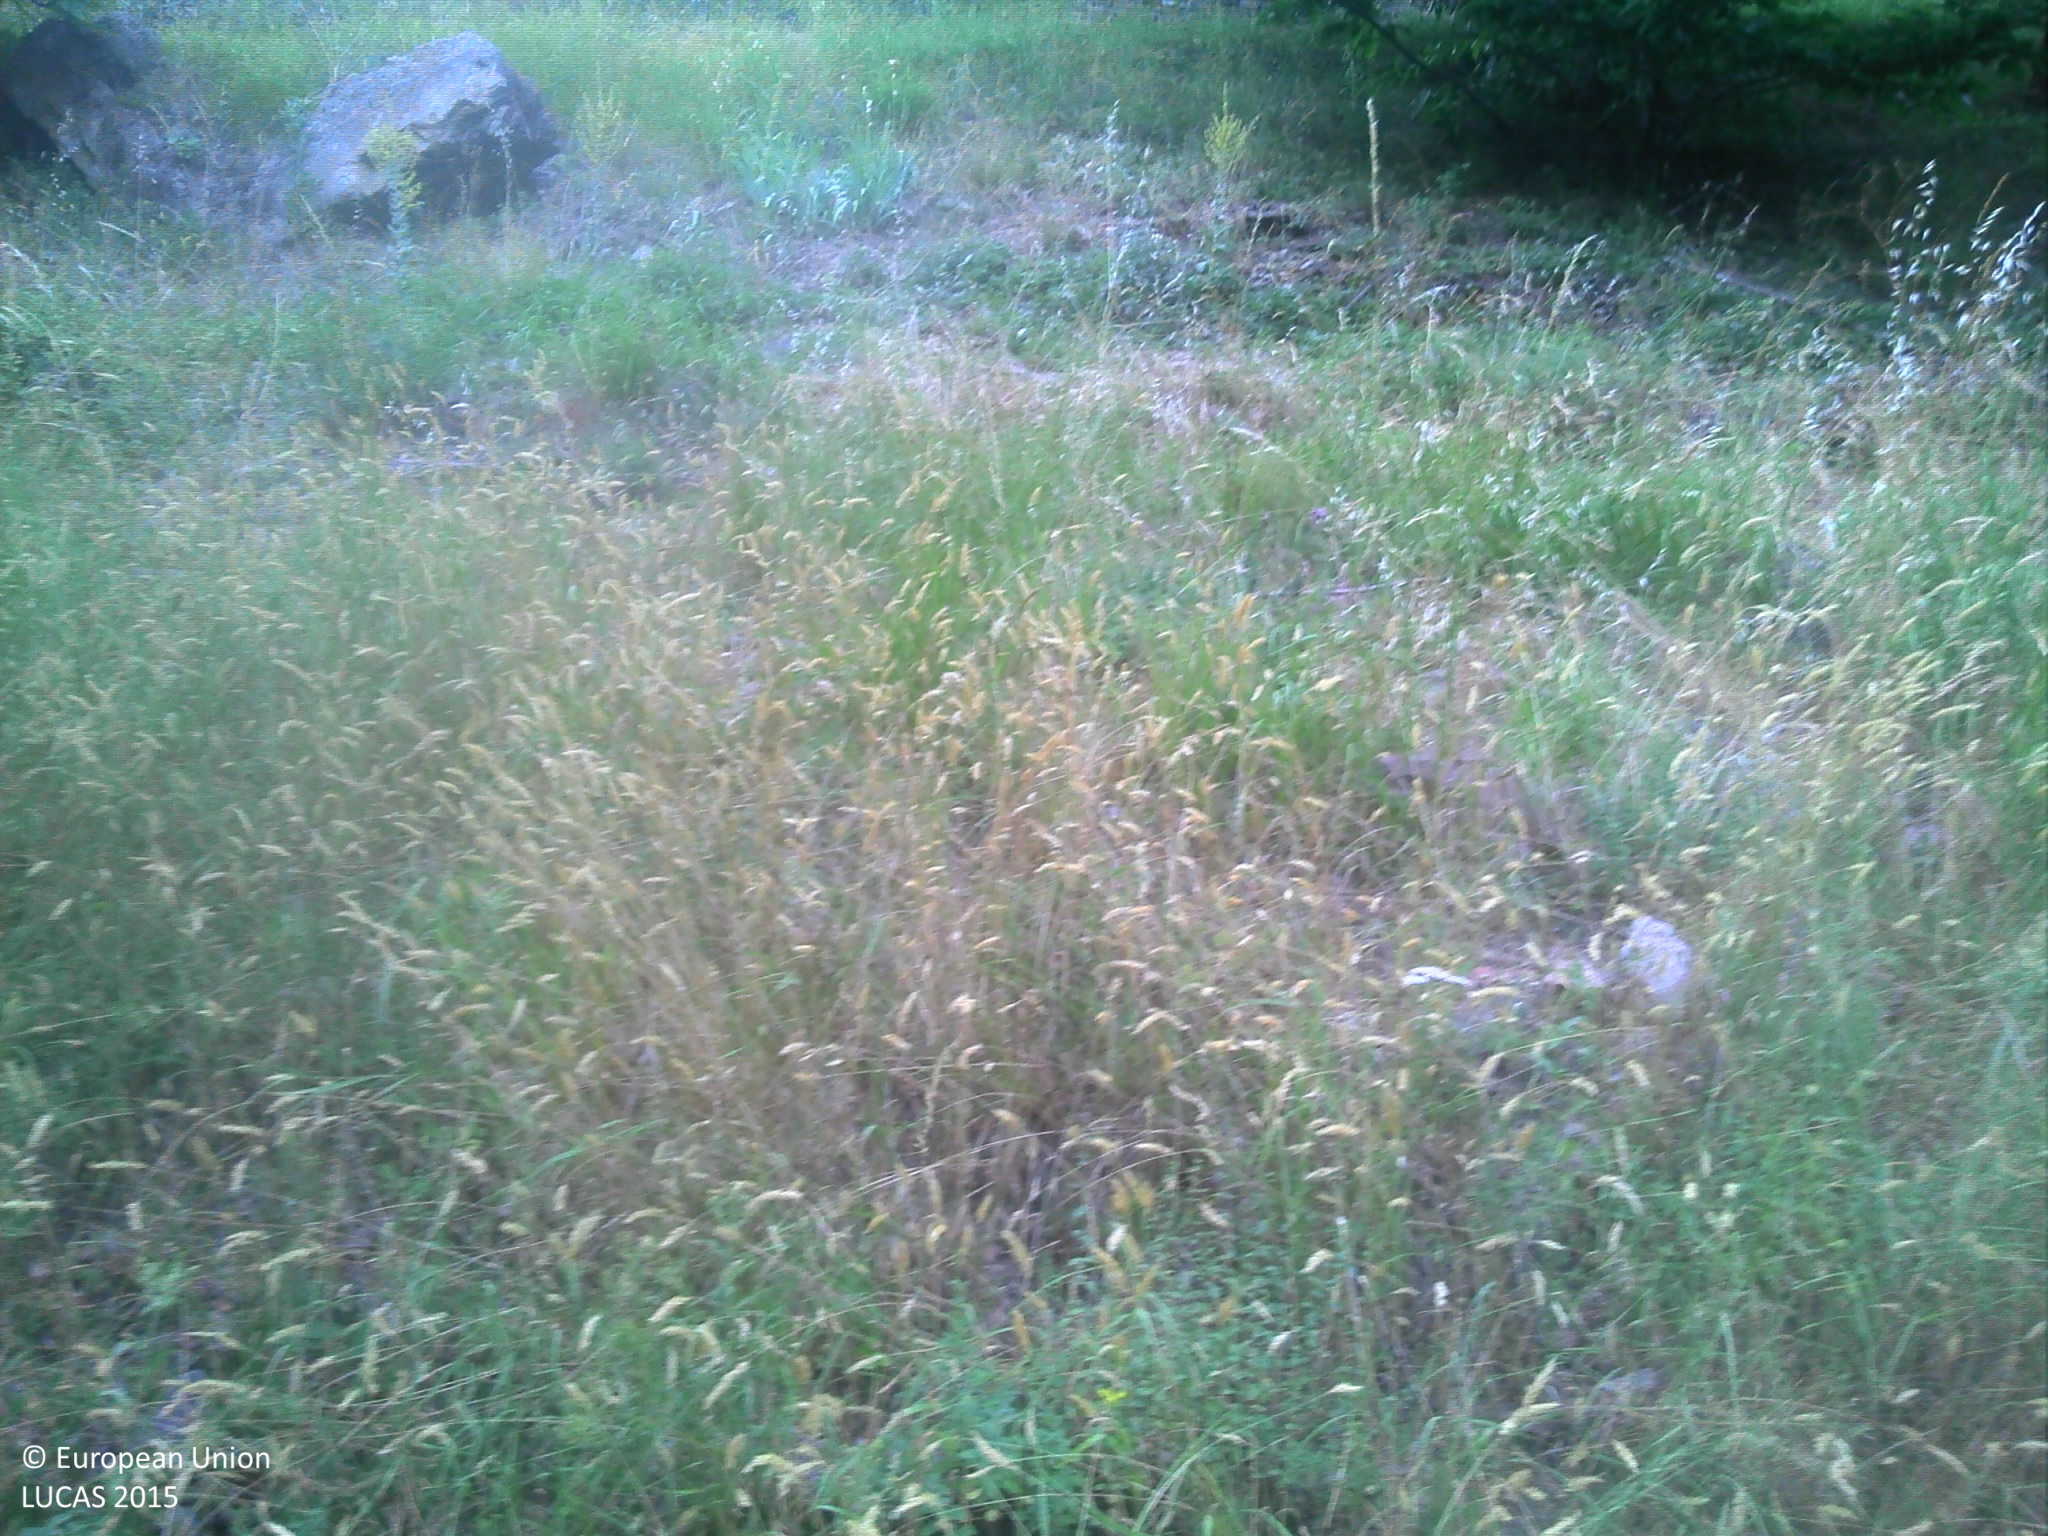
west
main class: Woodland
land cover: Broadleaved woodland
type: mesophytic deciduous forest
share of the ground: > 75 %
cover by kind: herbaceous plants 80 %, broadleaved forest trees 15 %, shrubs 5 %
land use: Forestry
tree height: > 5 m
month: June
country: FR
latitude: 44.3173
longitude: 3.9258
